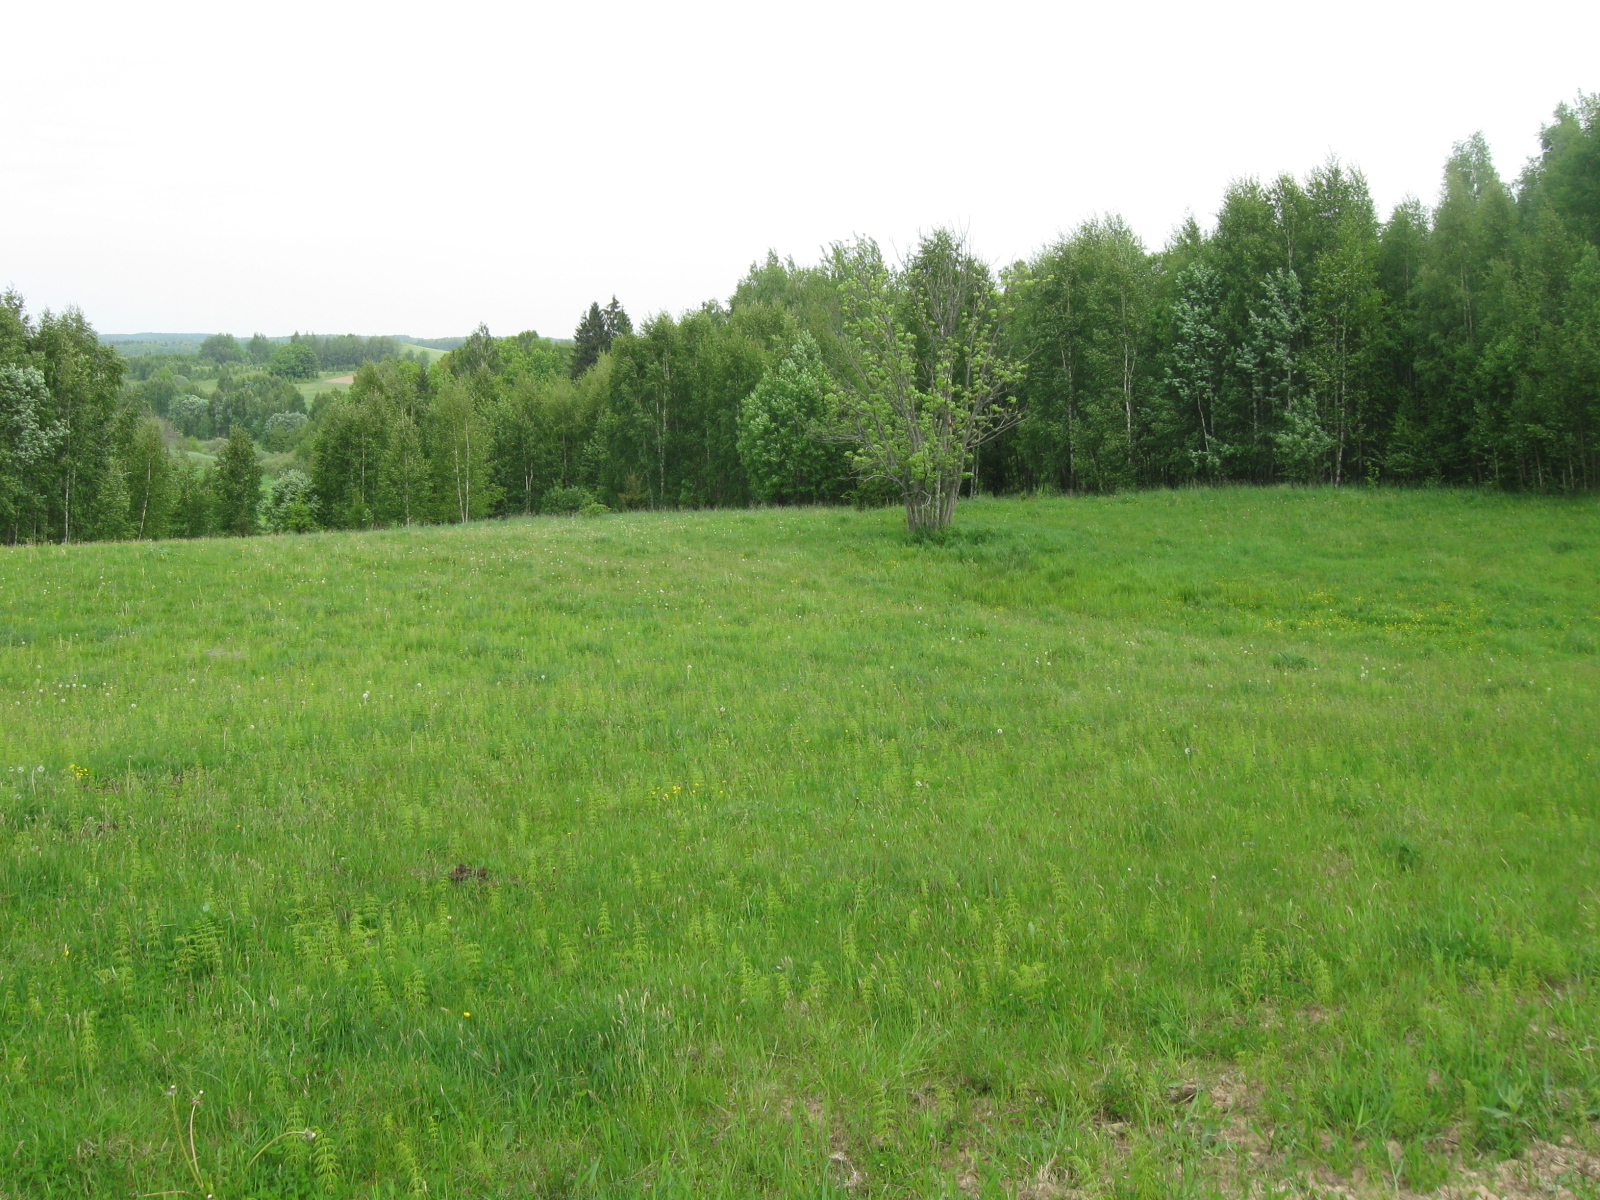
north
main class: Cropland
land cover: Oats
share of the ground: 25 - 50 %
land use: Agriculture (excluding fallow land and kitchen gardens)
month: May
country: LT
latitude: 54.4858
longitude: 22.8038
